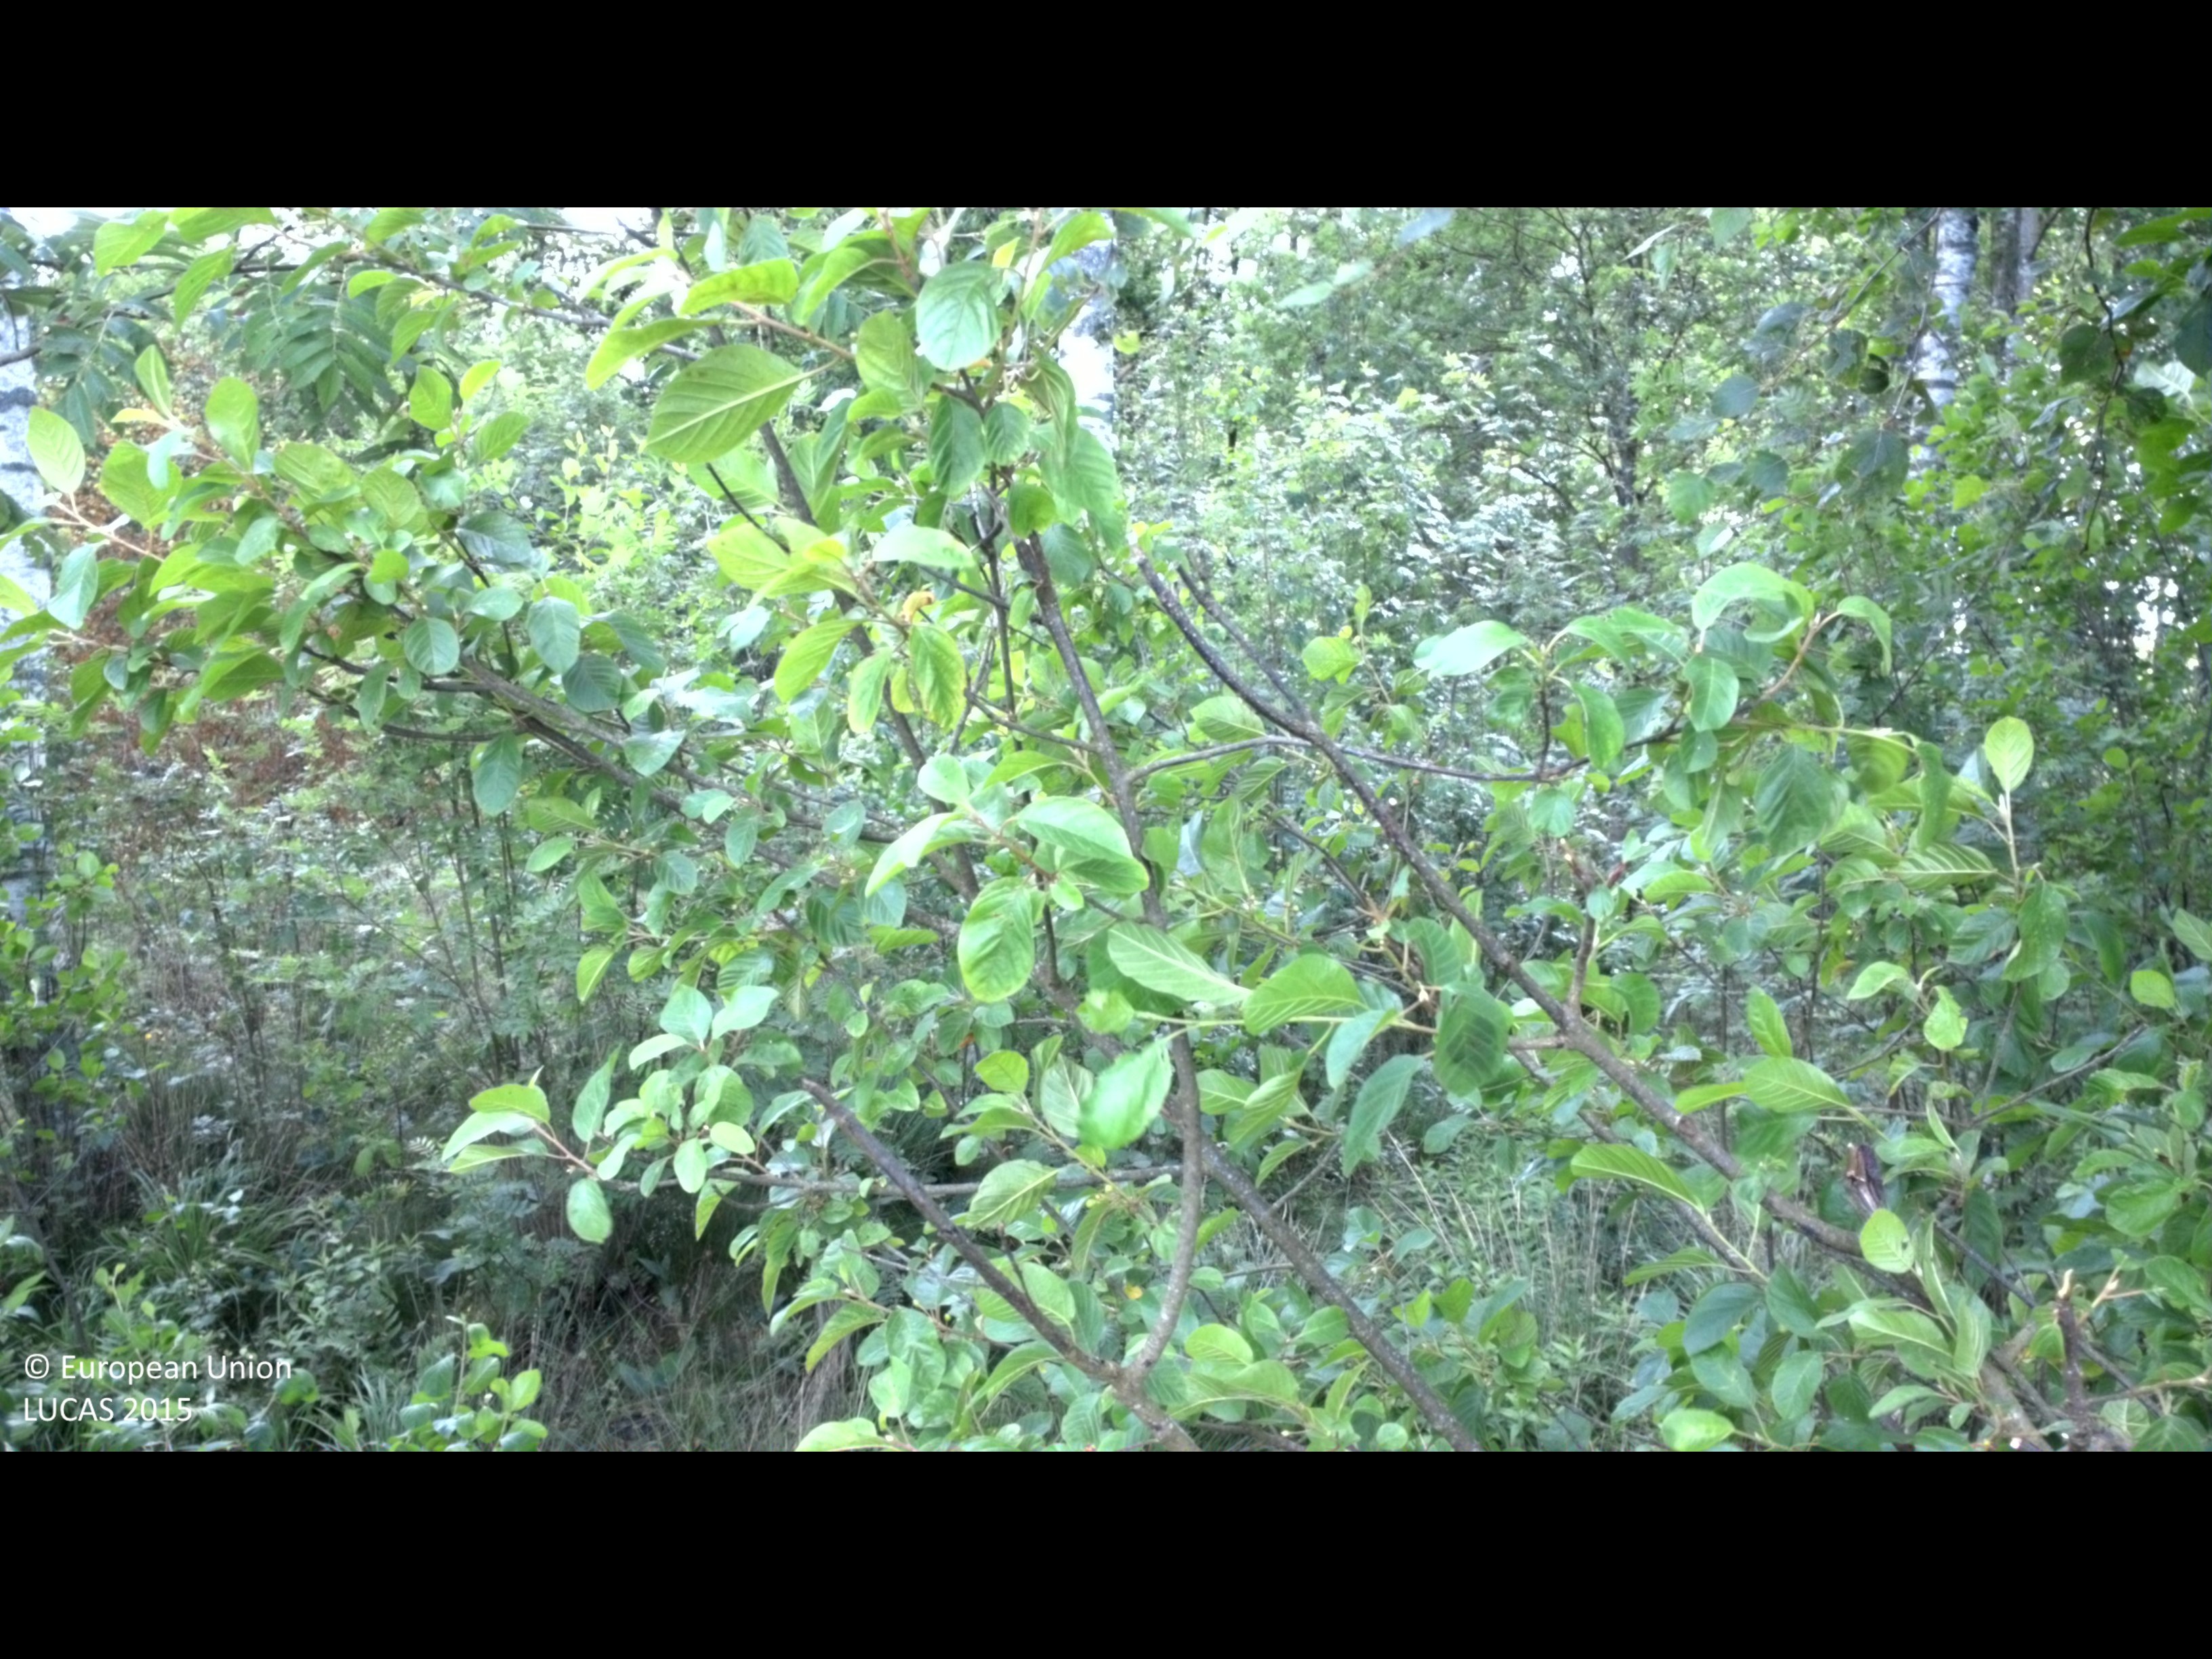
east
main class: Grassland
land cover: Grassland without tree/shrub cover
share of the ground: > 75 %
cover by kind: herbaceous plants 100 %
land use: Agriculture (excluding fallow land and kitchen gardens)
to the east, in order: Grassland without tree/shrub cover; Fences; Ditches and canals; Broadleaved woodland; Artificial constructions in urban areas; Grass margins; Paved roads, cycling and walking lanes; Grass margins; Broadleaved woodland
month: July
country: SE
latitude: 56.5476
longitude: 14.3077
